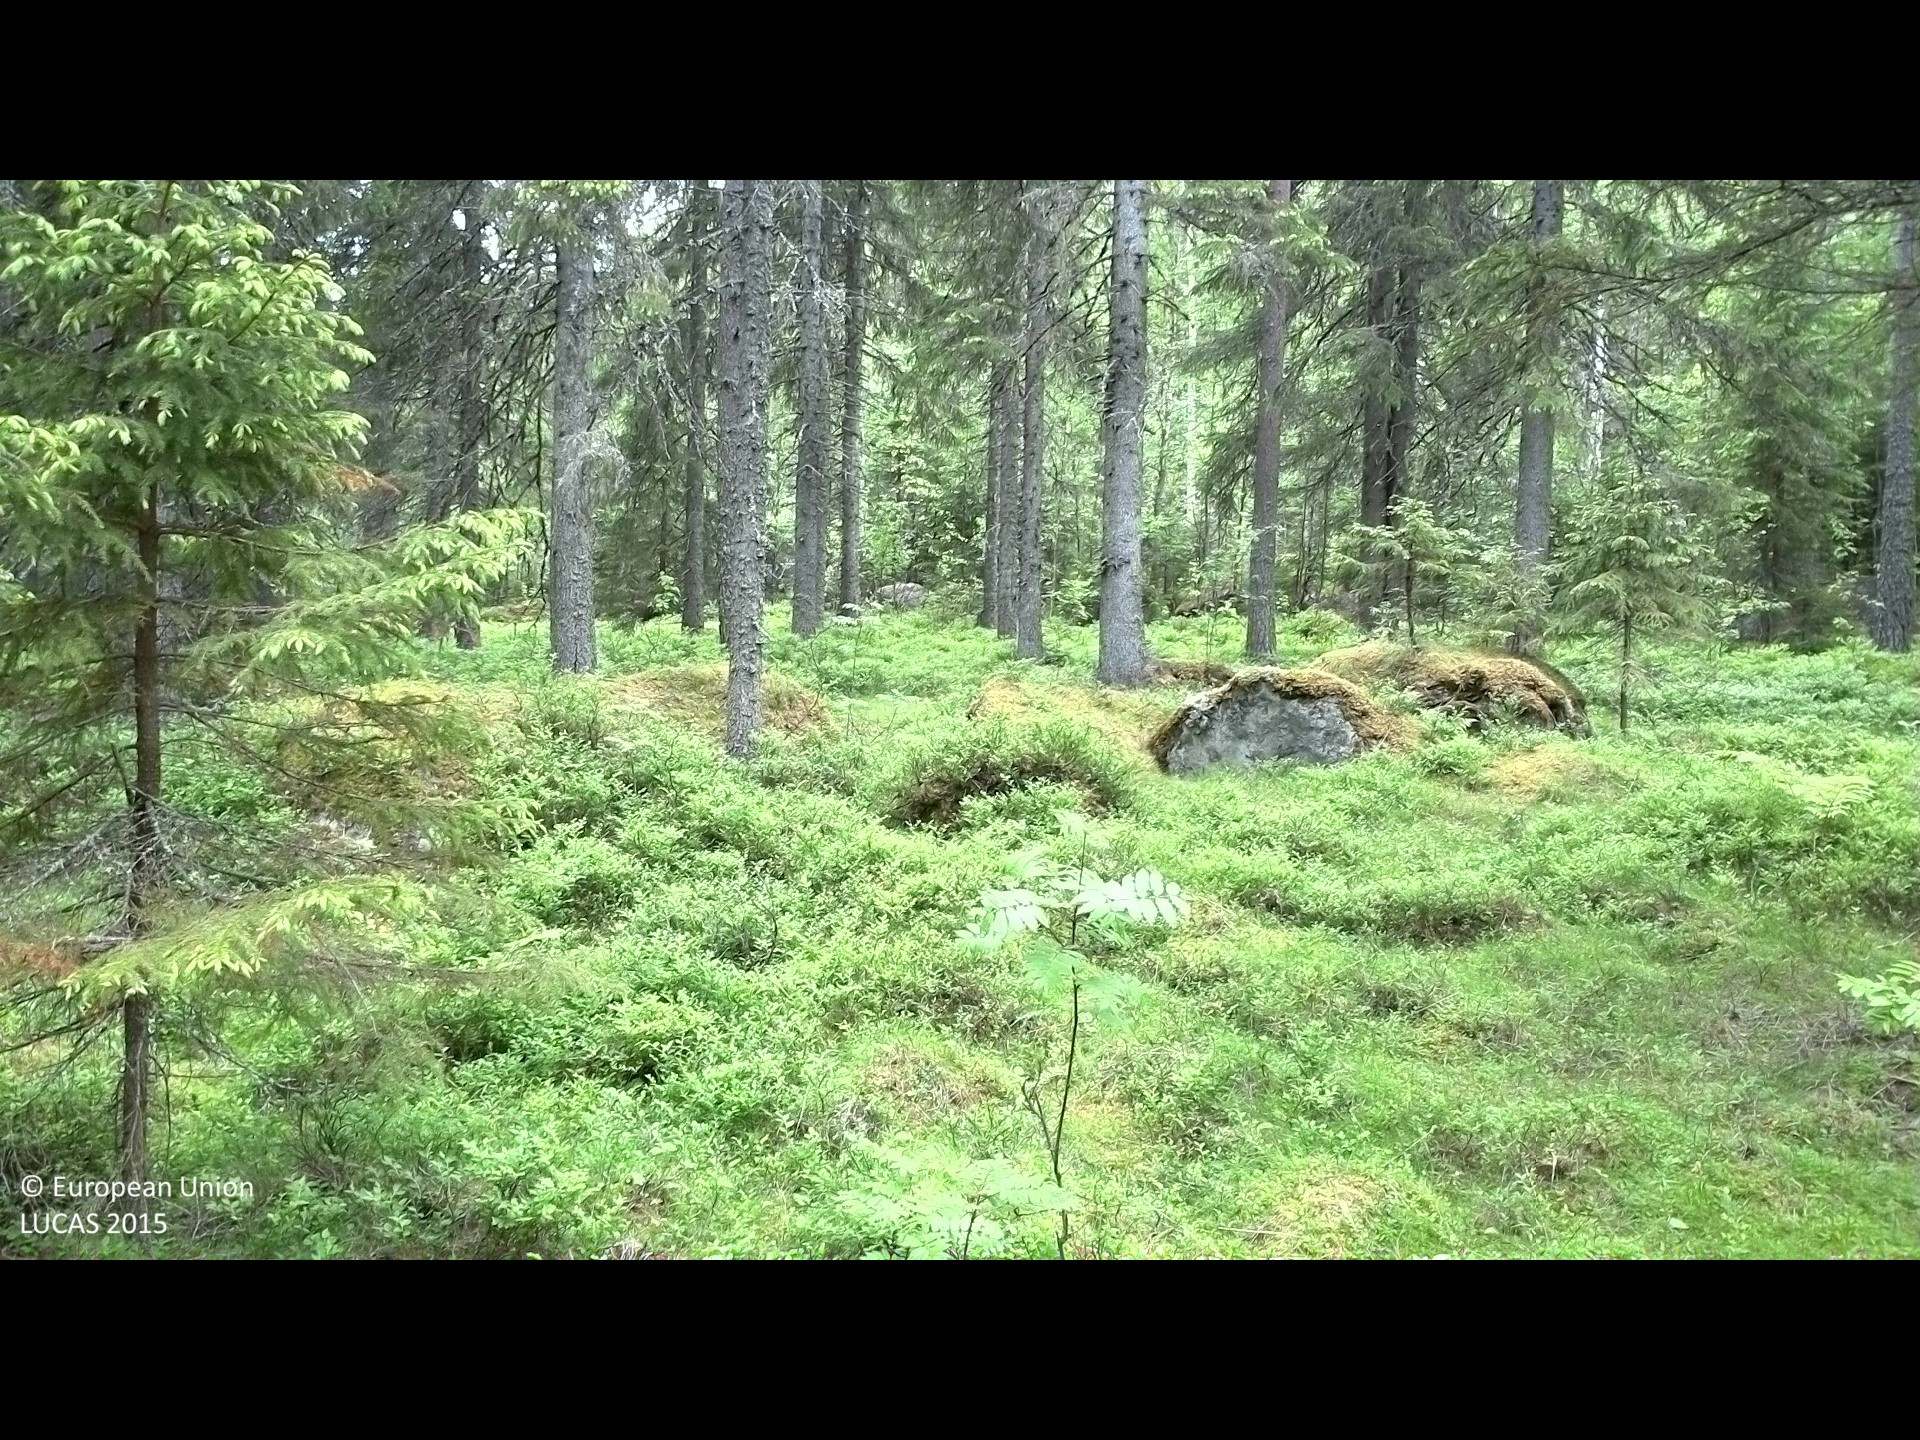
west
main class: Woodland
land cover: Spruce dominated coniferous woodland
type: boreal forest
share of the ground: 25 - 50 %
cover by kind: shrubs 40 %, coniferous forest trees 35 %, herbaceous plants 15 %, broadleaved forest trees 5 %, lichens and mosses 5 %
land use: Forestry
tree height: > 5 m
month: June
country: SE
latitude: 61.9472
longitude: 16.9014
